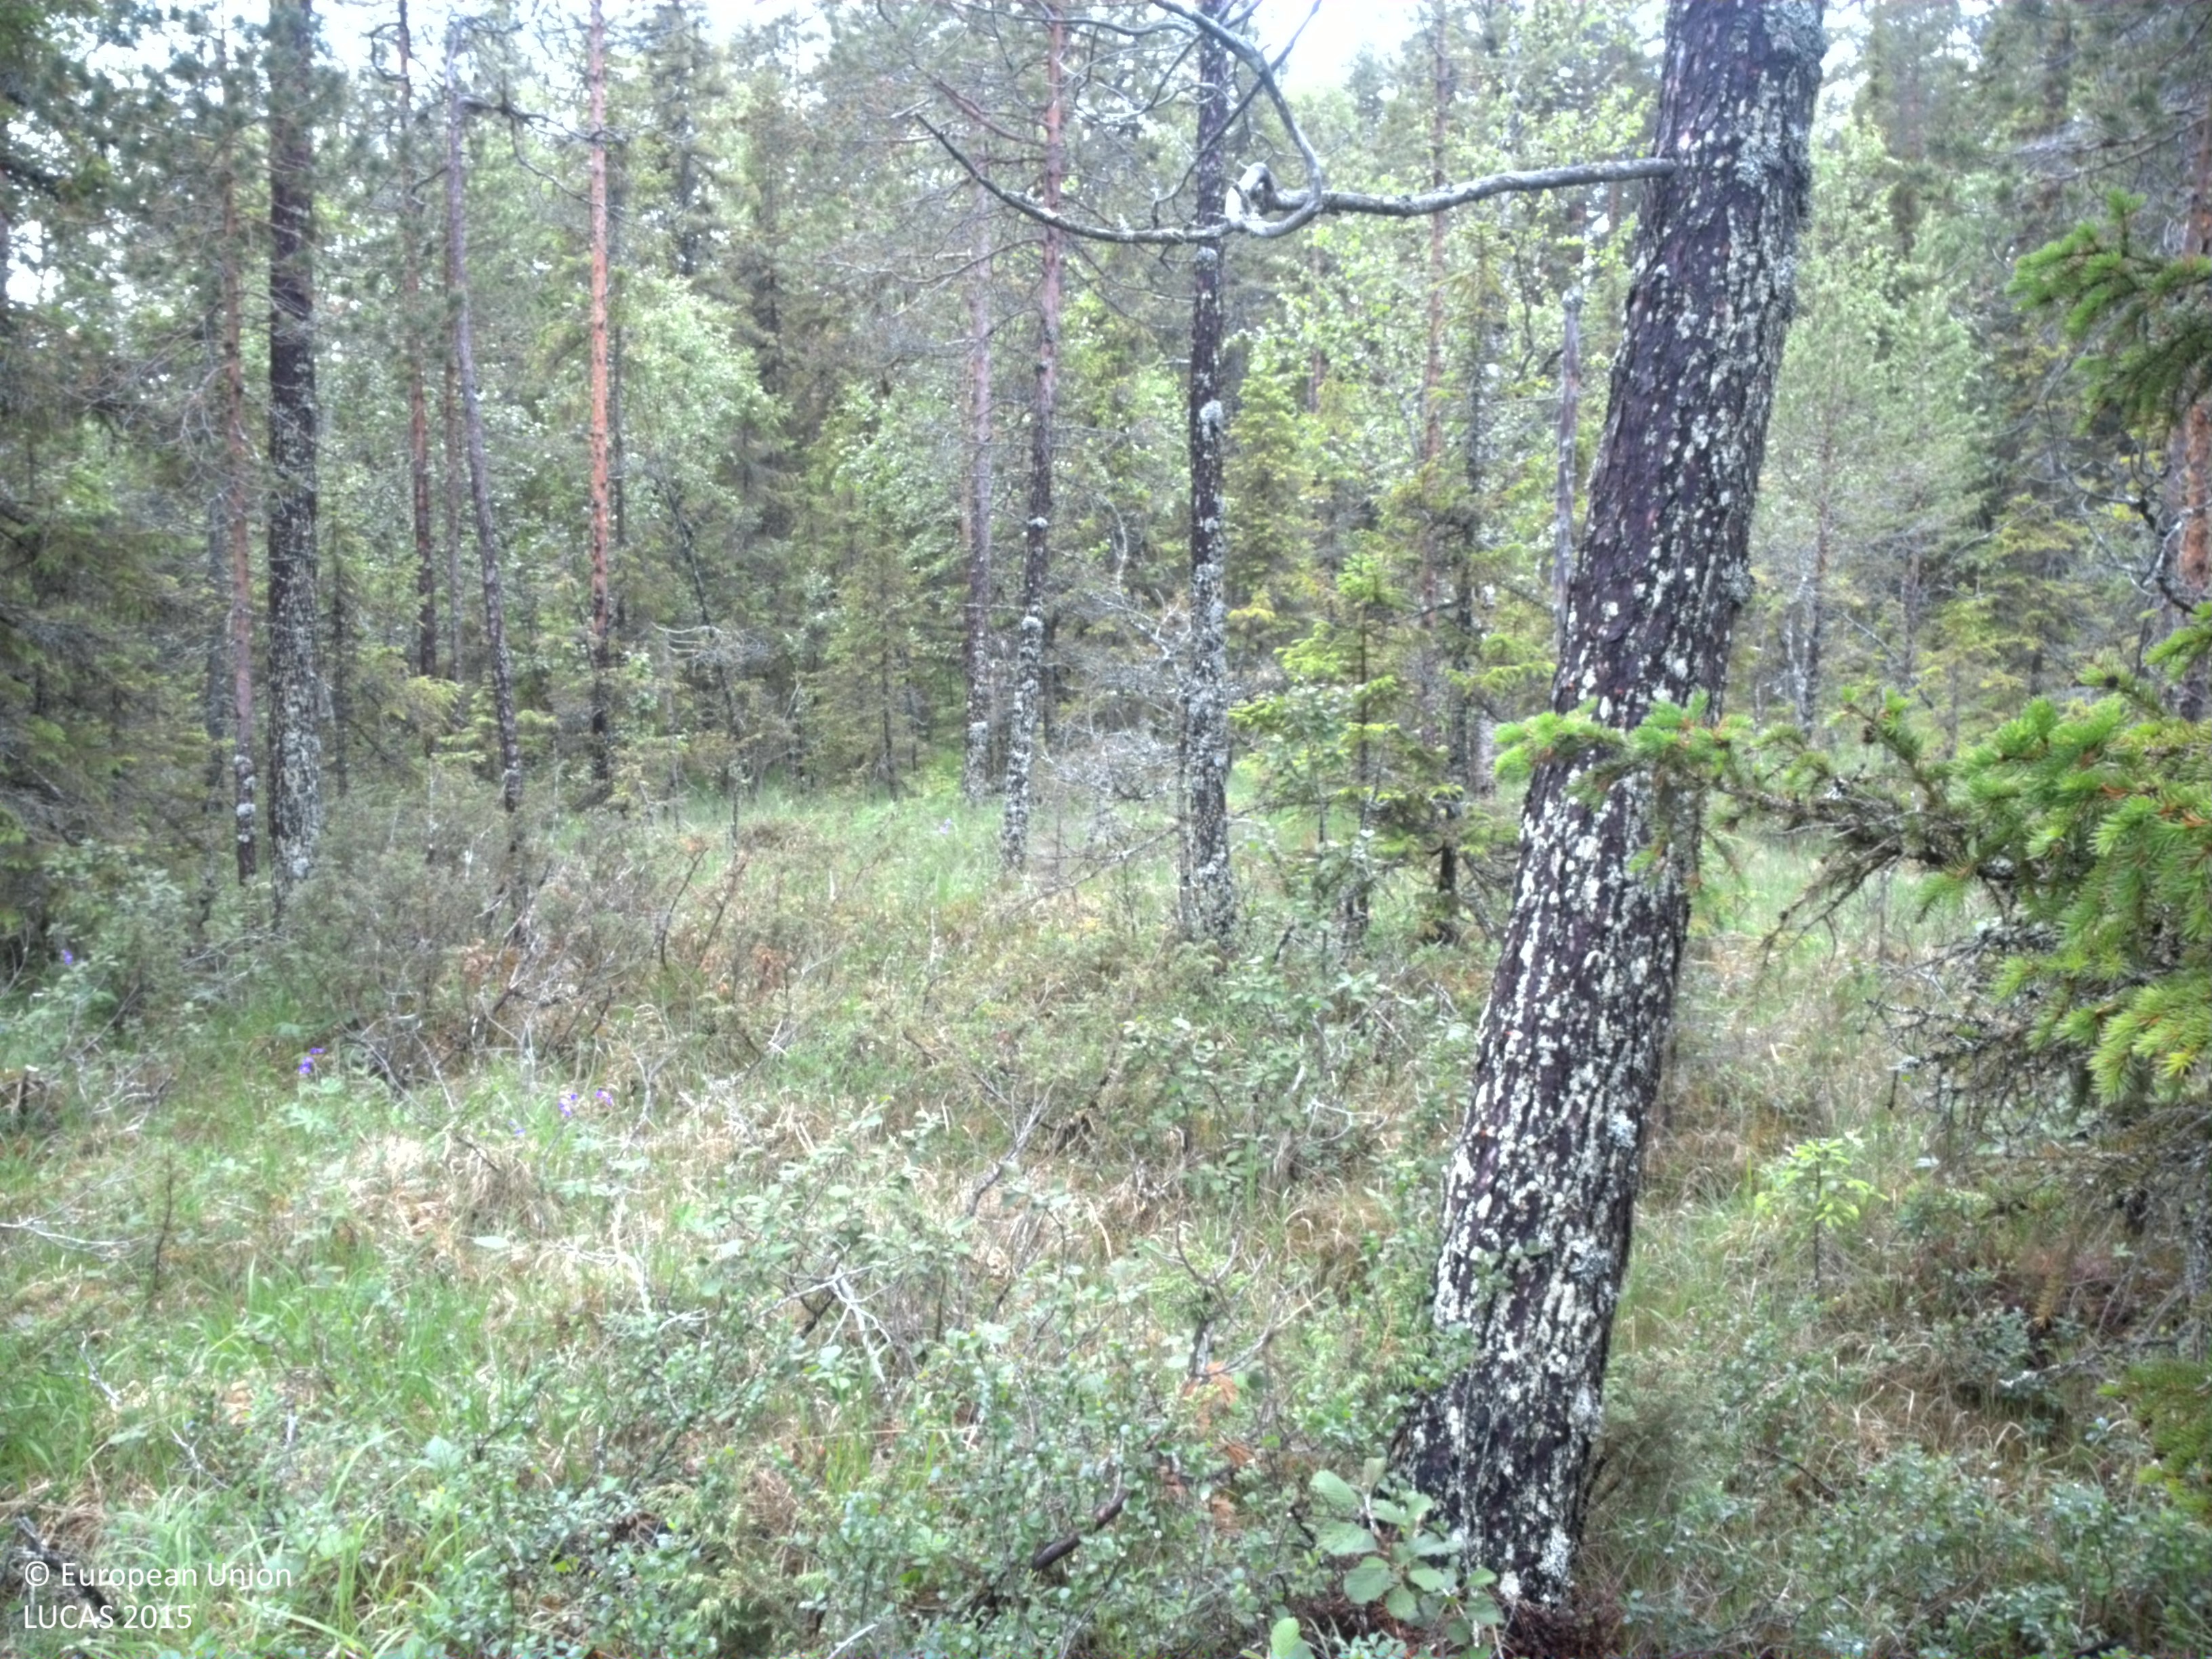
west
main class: Woodland
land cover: Pine dominated mixed woodland
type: boreal forest
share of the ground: 50 - 75 %
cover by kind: coniferous forest trees 45 %, shrubs 20 %, herbaceous plants 20 %, broadleaved forest trees 15 %
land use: Amenities, museums, leisure
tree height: > 5 m
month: July
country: SE
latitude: 64.6523
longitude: 18.3199
